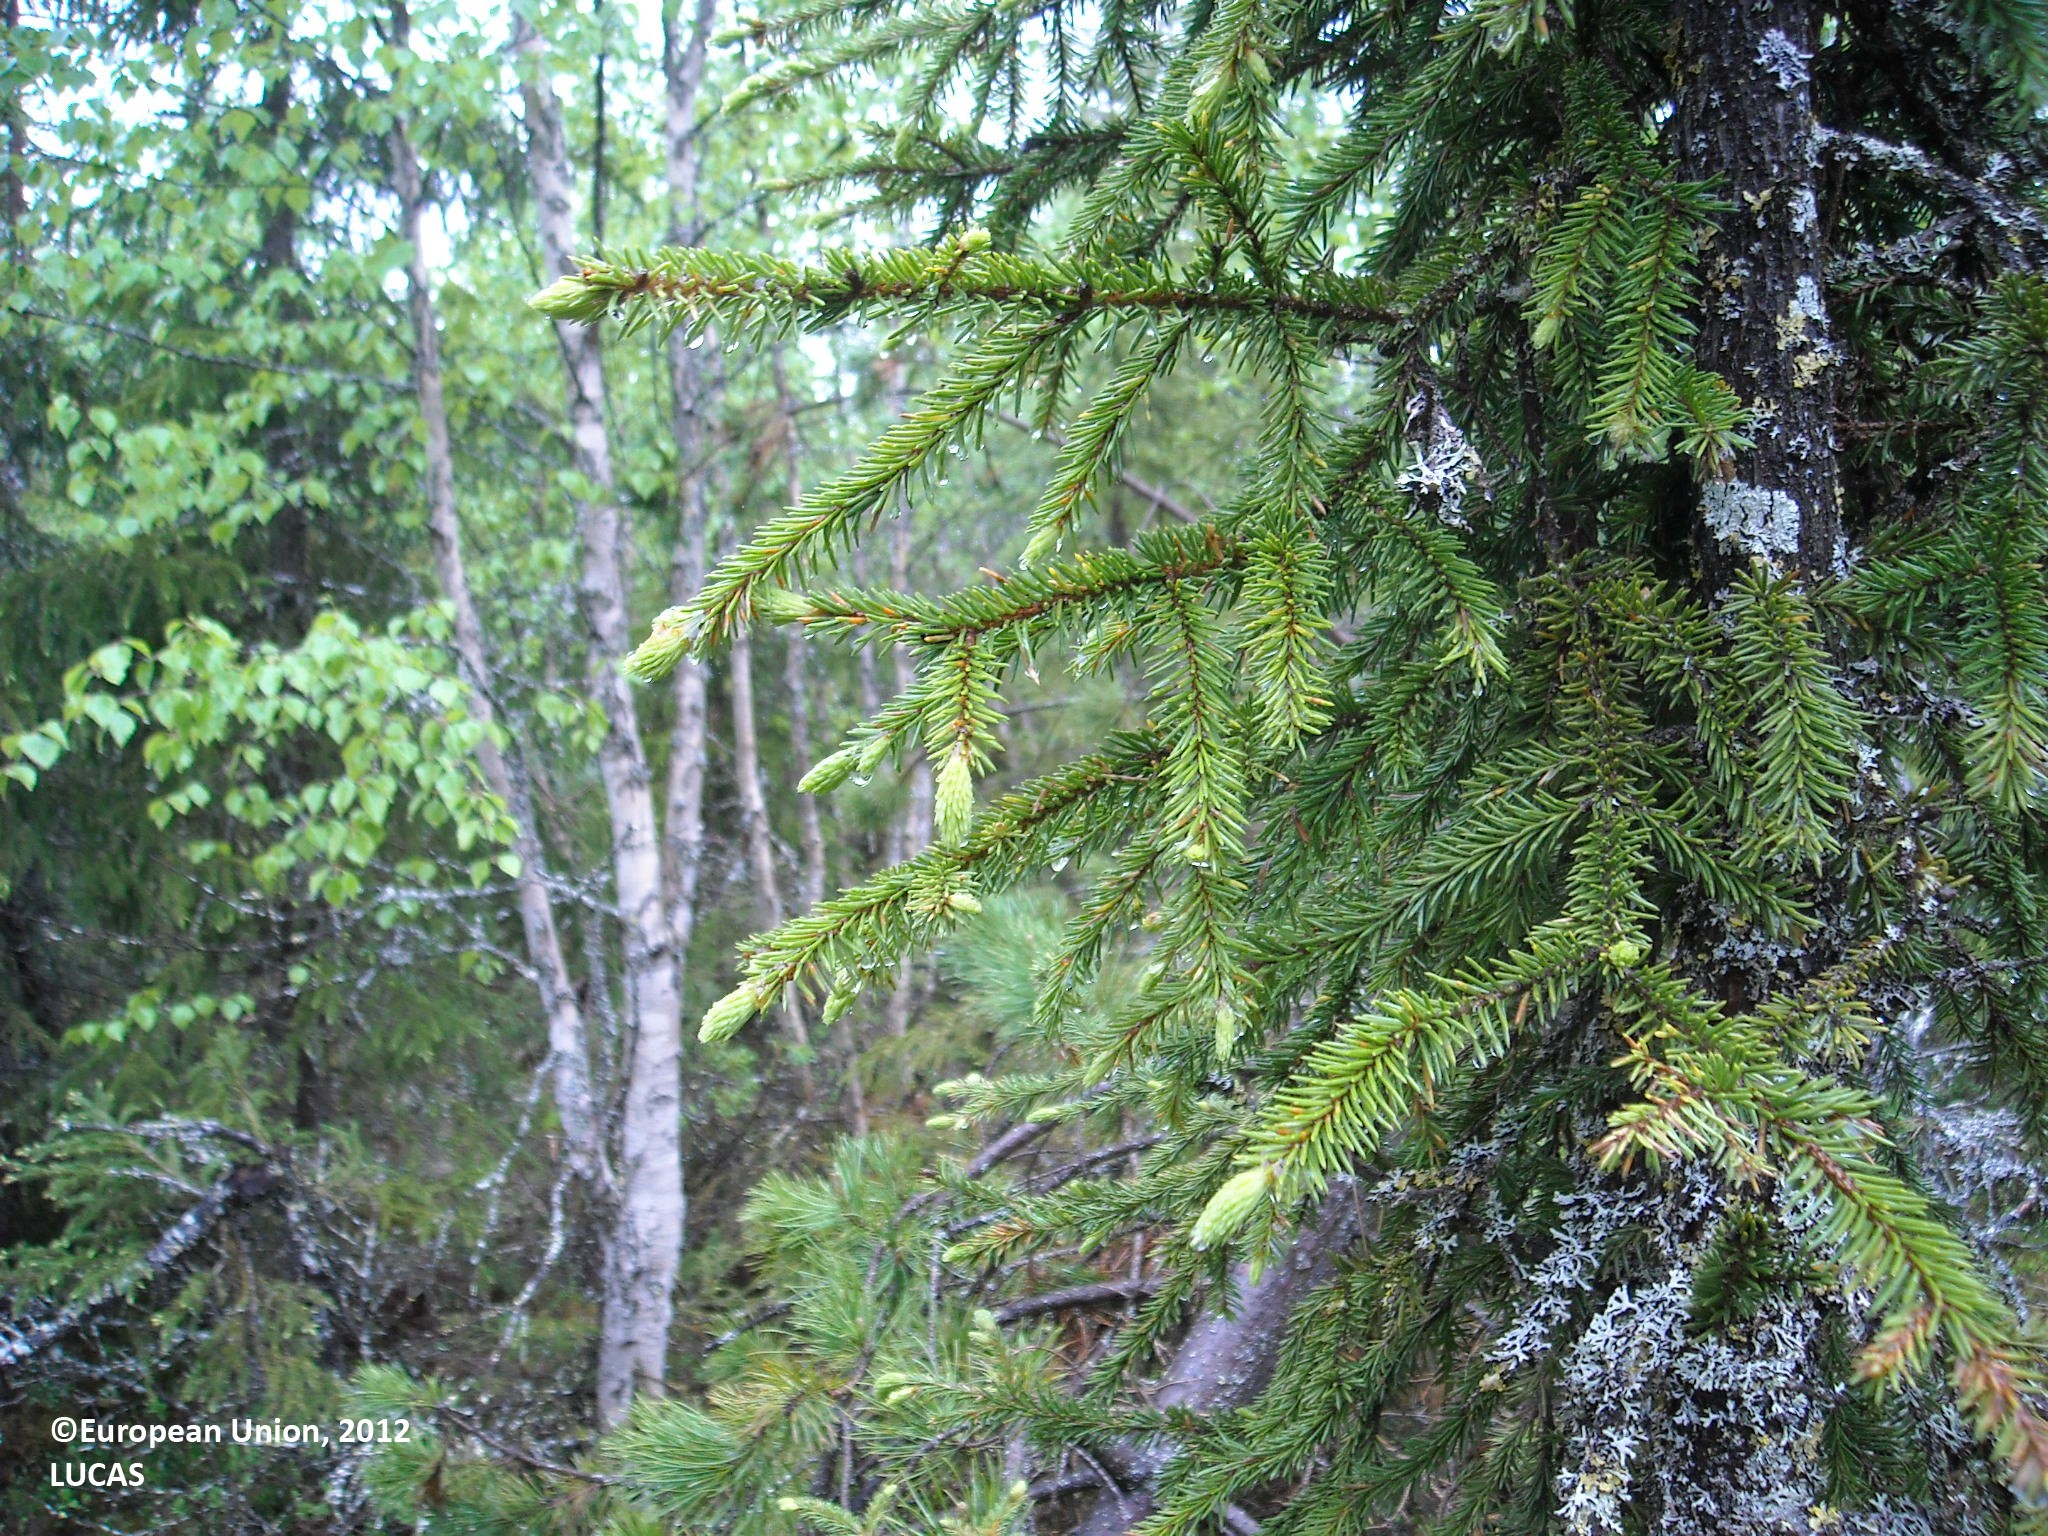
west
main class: Woodland
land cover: Other mixed woodland
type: boreal forest
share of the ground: > 75 %
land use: Forestry
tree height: > 5 m
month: June
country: FI
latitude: 65.5816
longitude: 27.9401
